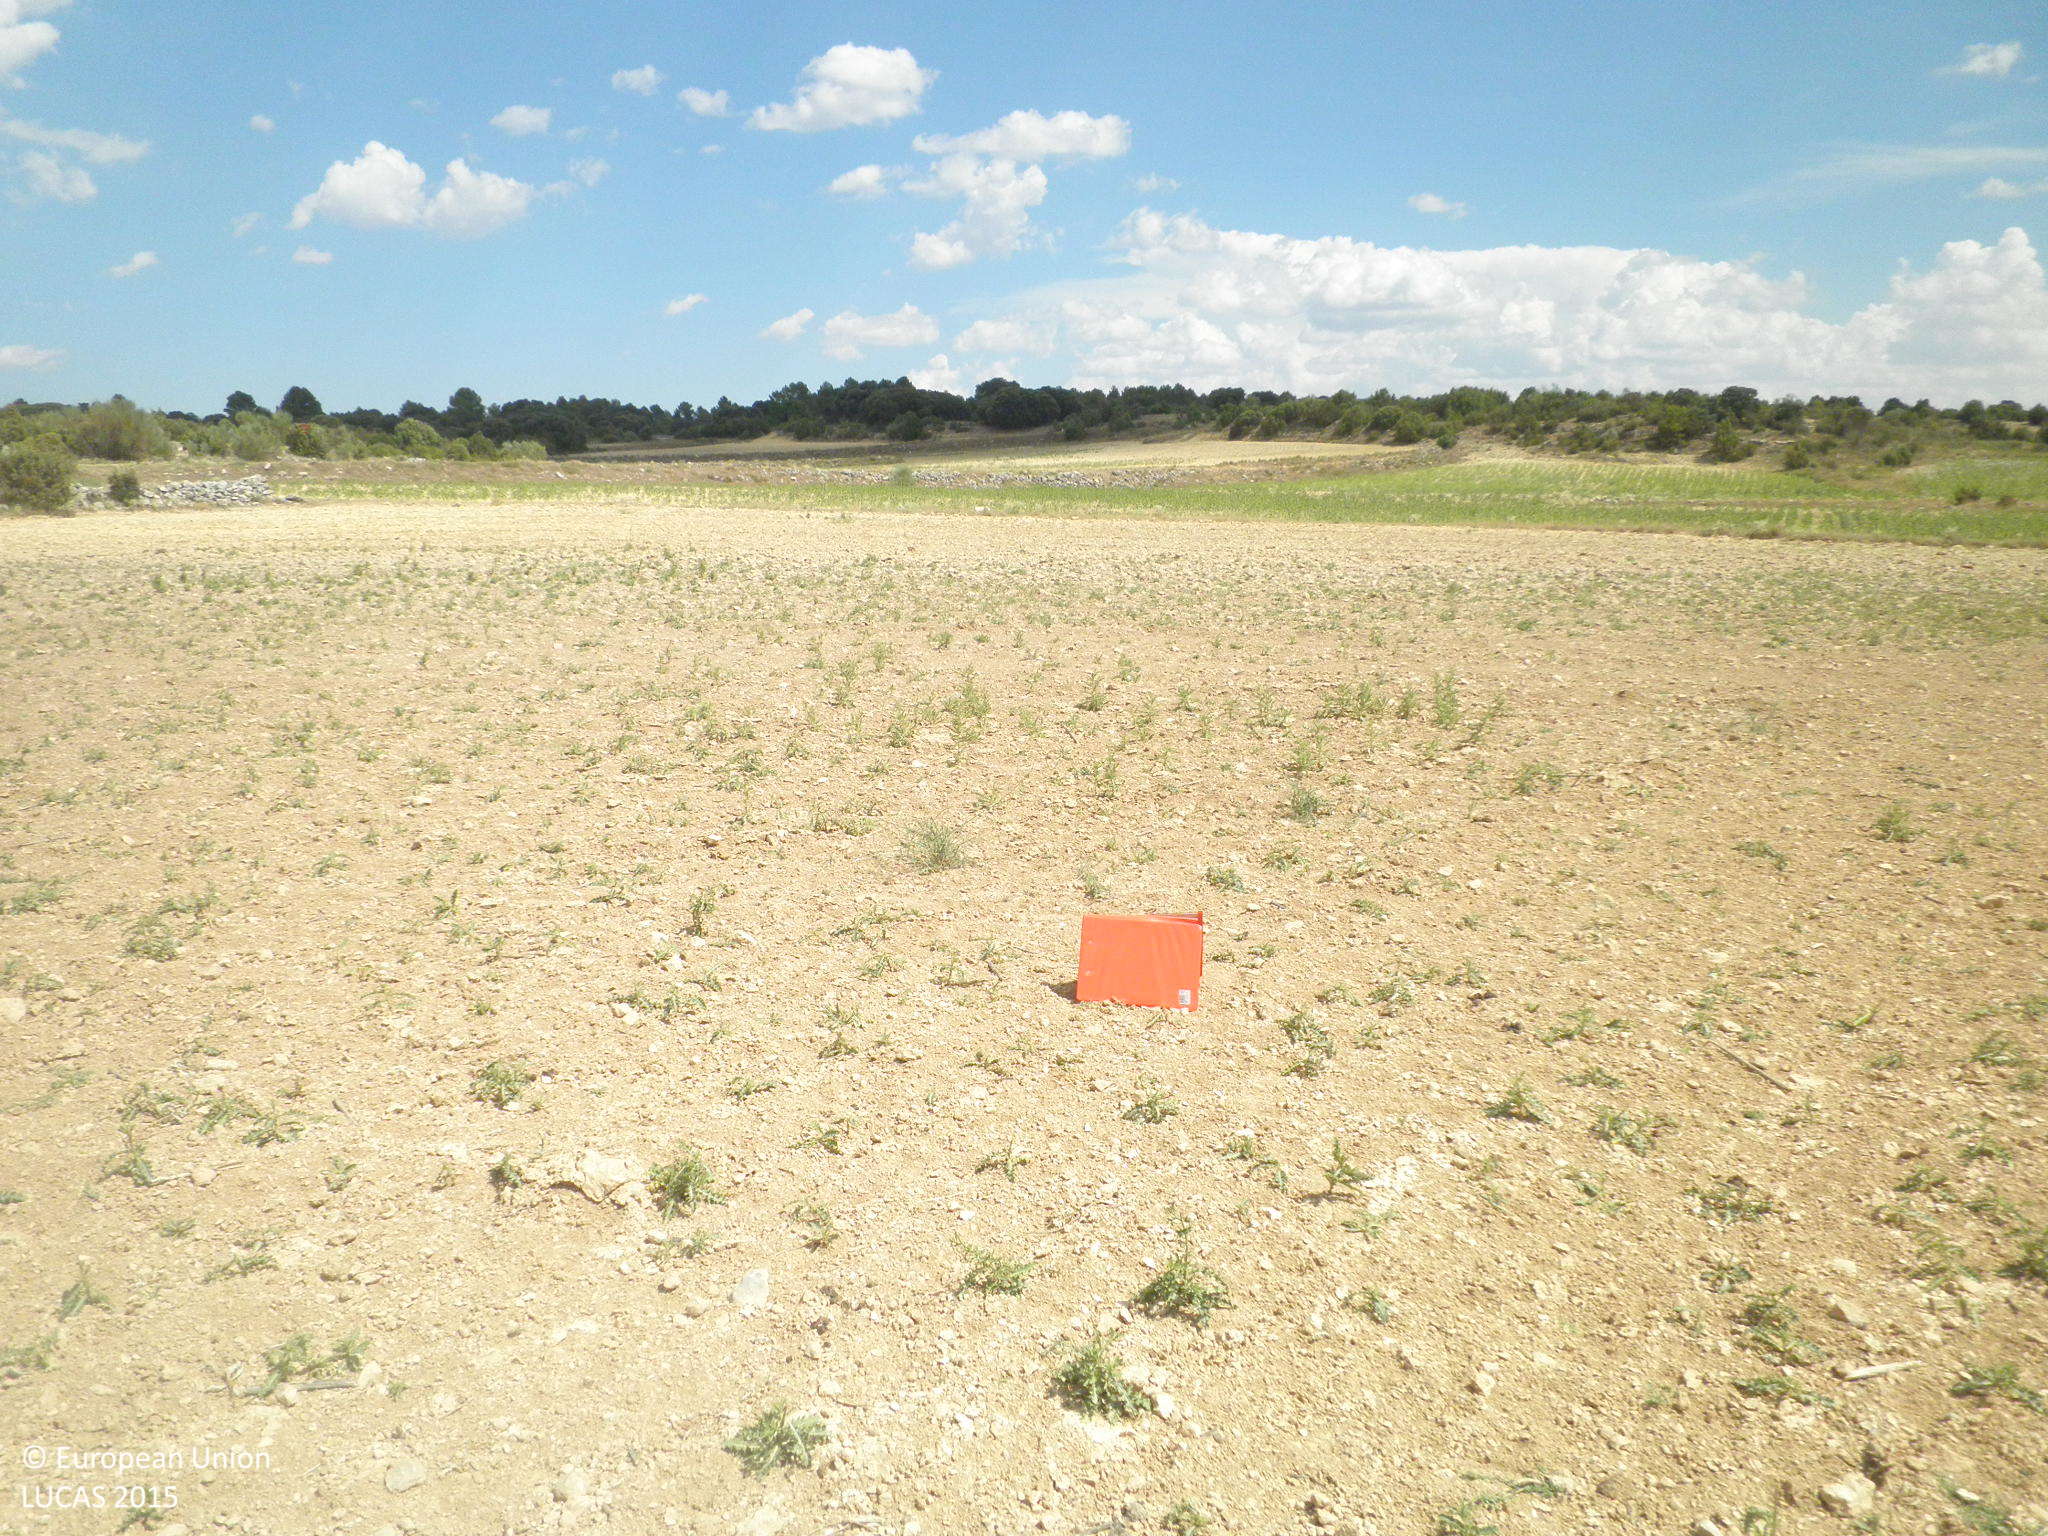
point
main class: Grassland
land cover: Spontaneously vegetated surfaces
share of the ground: 10 - 25 %
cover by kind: unconsolidated bare surface 90 %, herbaceous plants 10 %
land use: Fallow land
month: July
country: ES
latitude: 39.6413
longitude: -1.6711
